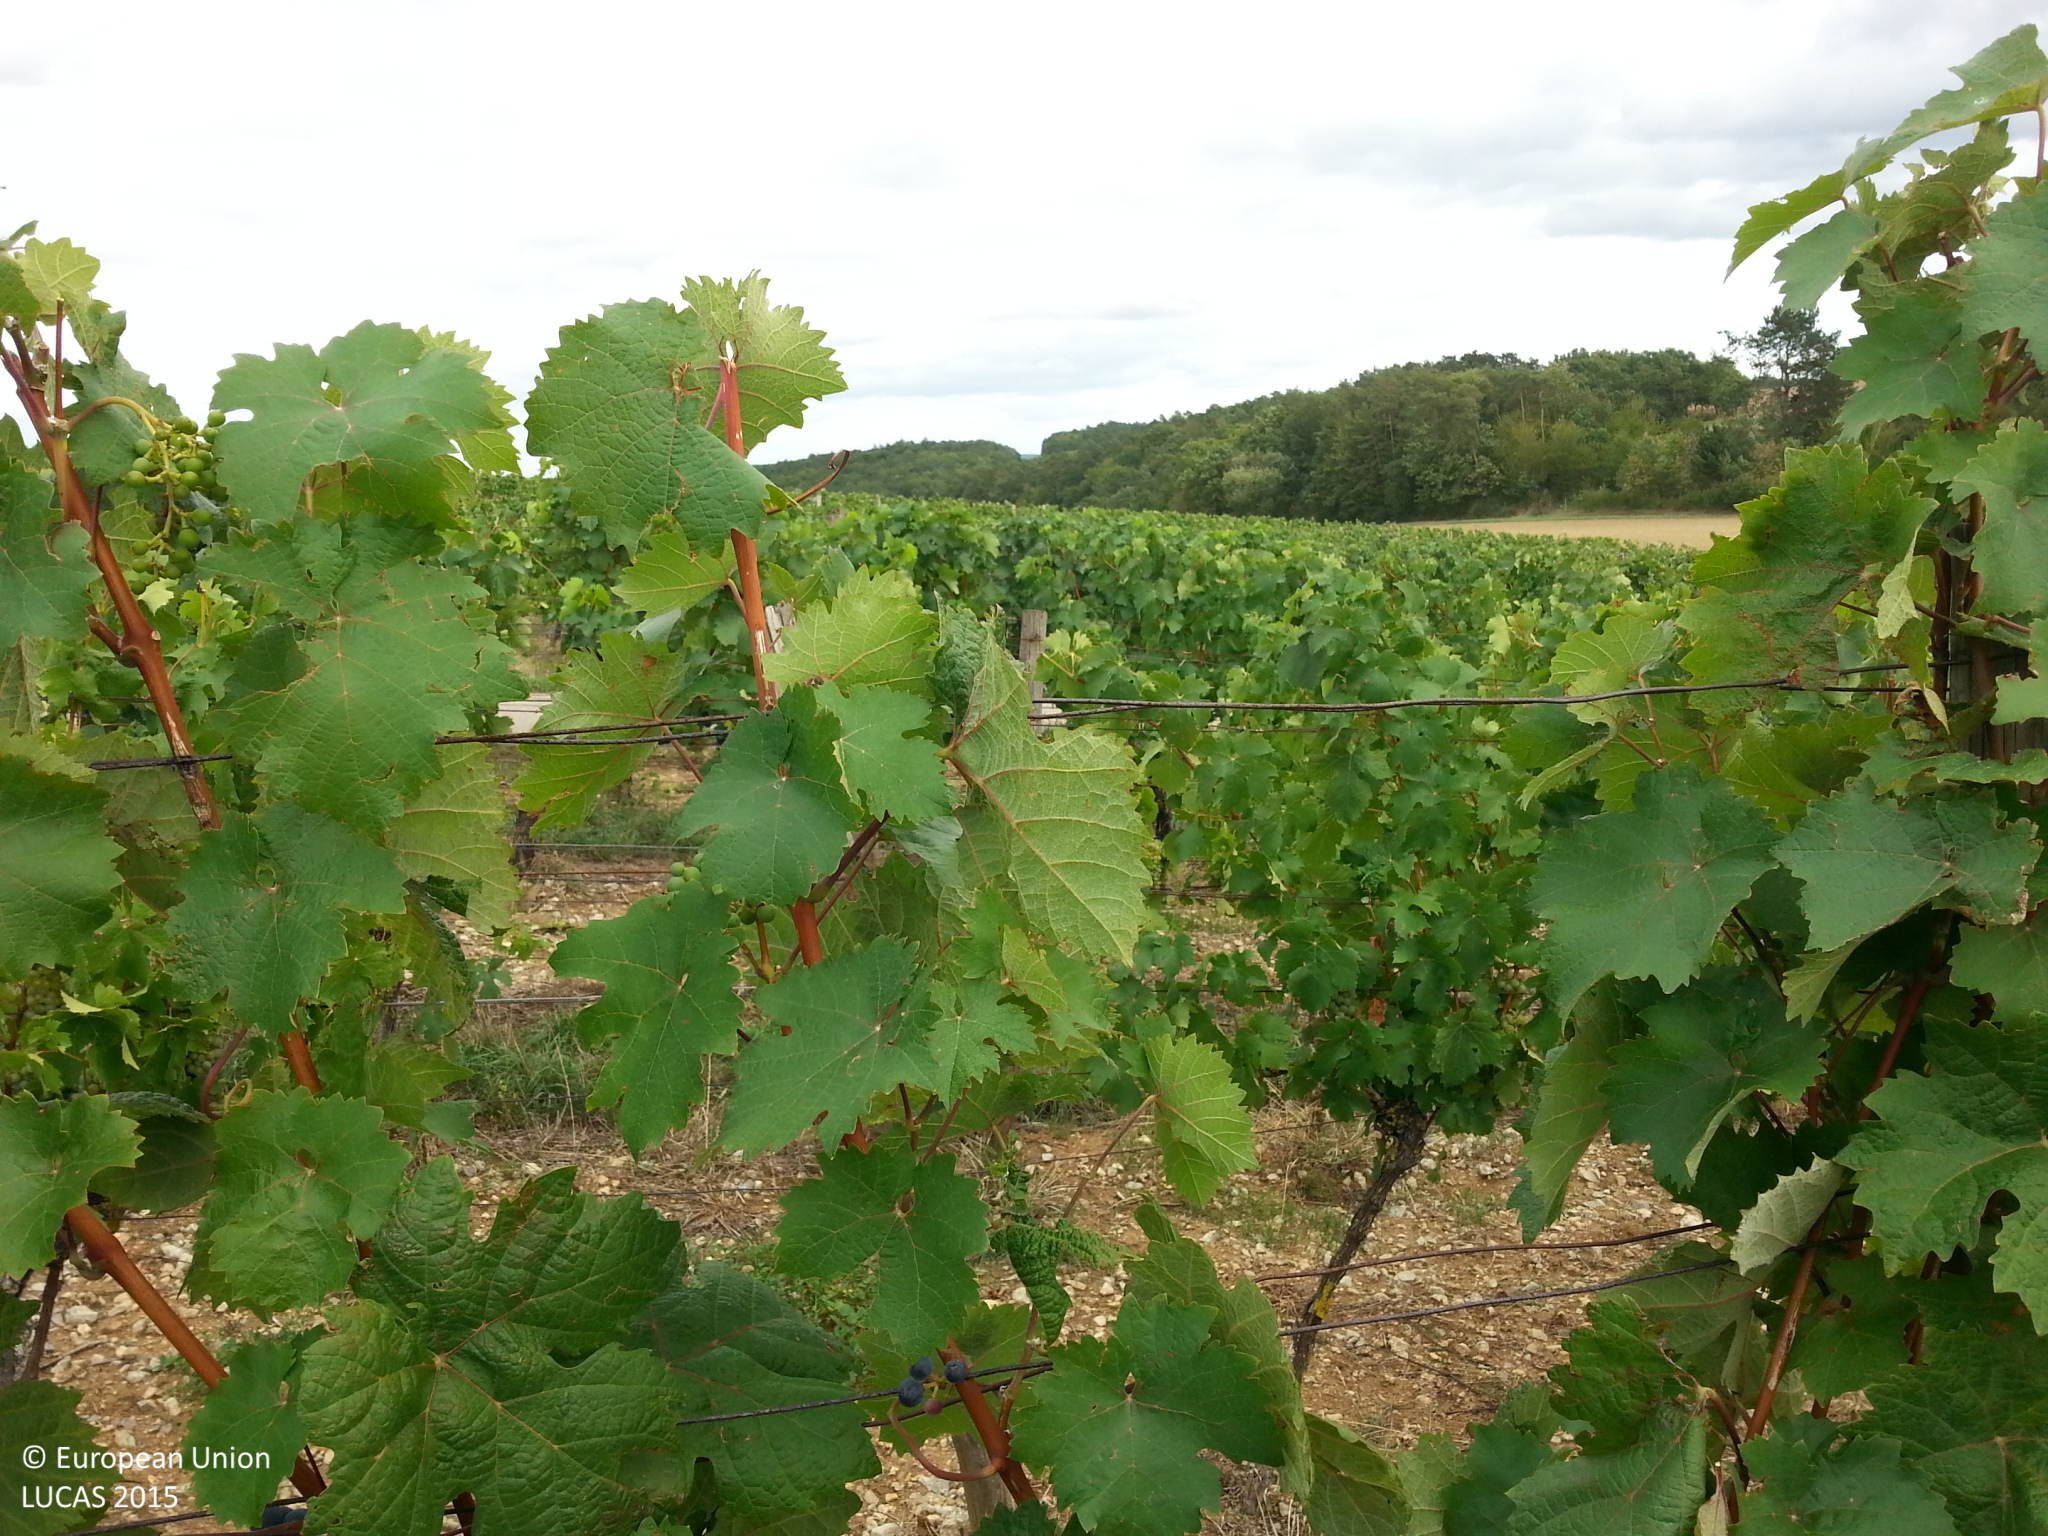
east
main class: Cropland
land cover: Vineyards
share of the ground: 50 - 75 %
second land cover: Spontaneously vegetated surfaces
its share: 10 - 25 %
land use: Agriculture (excluding fallow land and kitchen gardens)
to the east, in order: Vineyards; Spontaneously vegetated surfaces; Tracks; Vineyards; Tracks; Vineyards
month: September
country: DE
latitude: 49.6080
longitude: 9.5988
